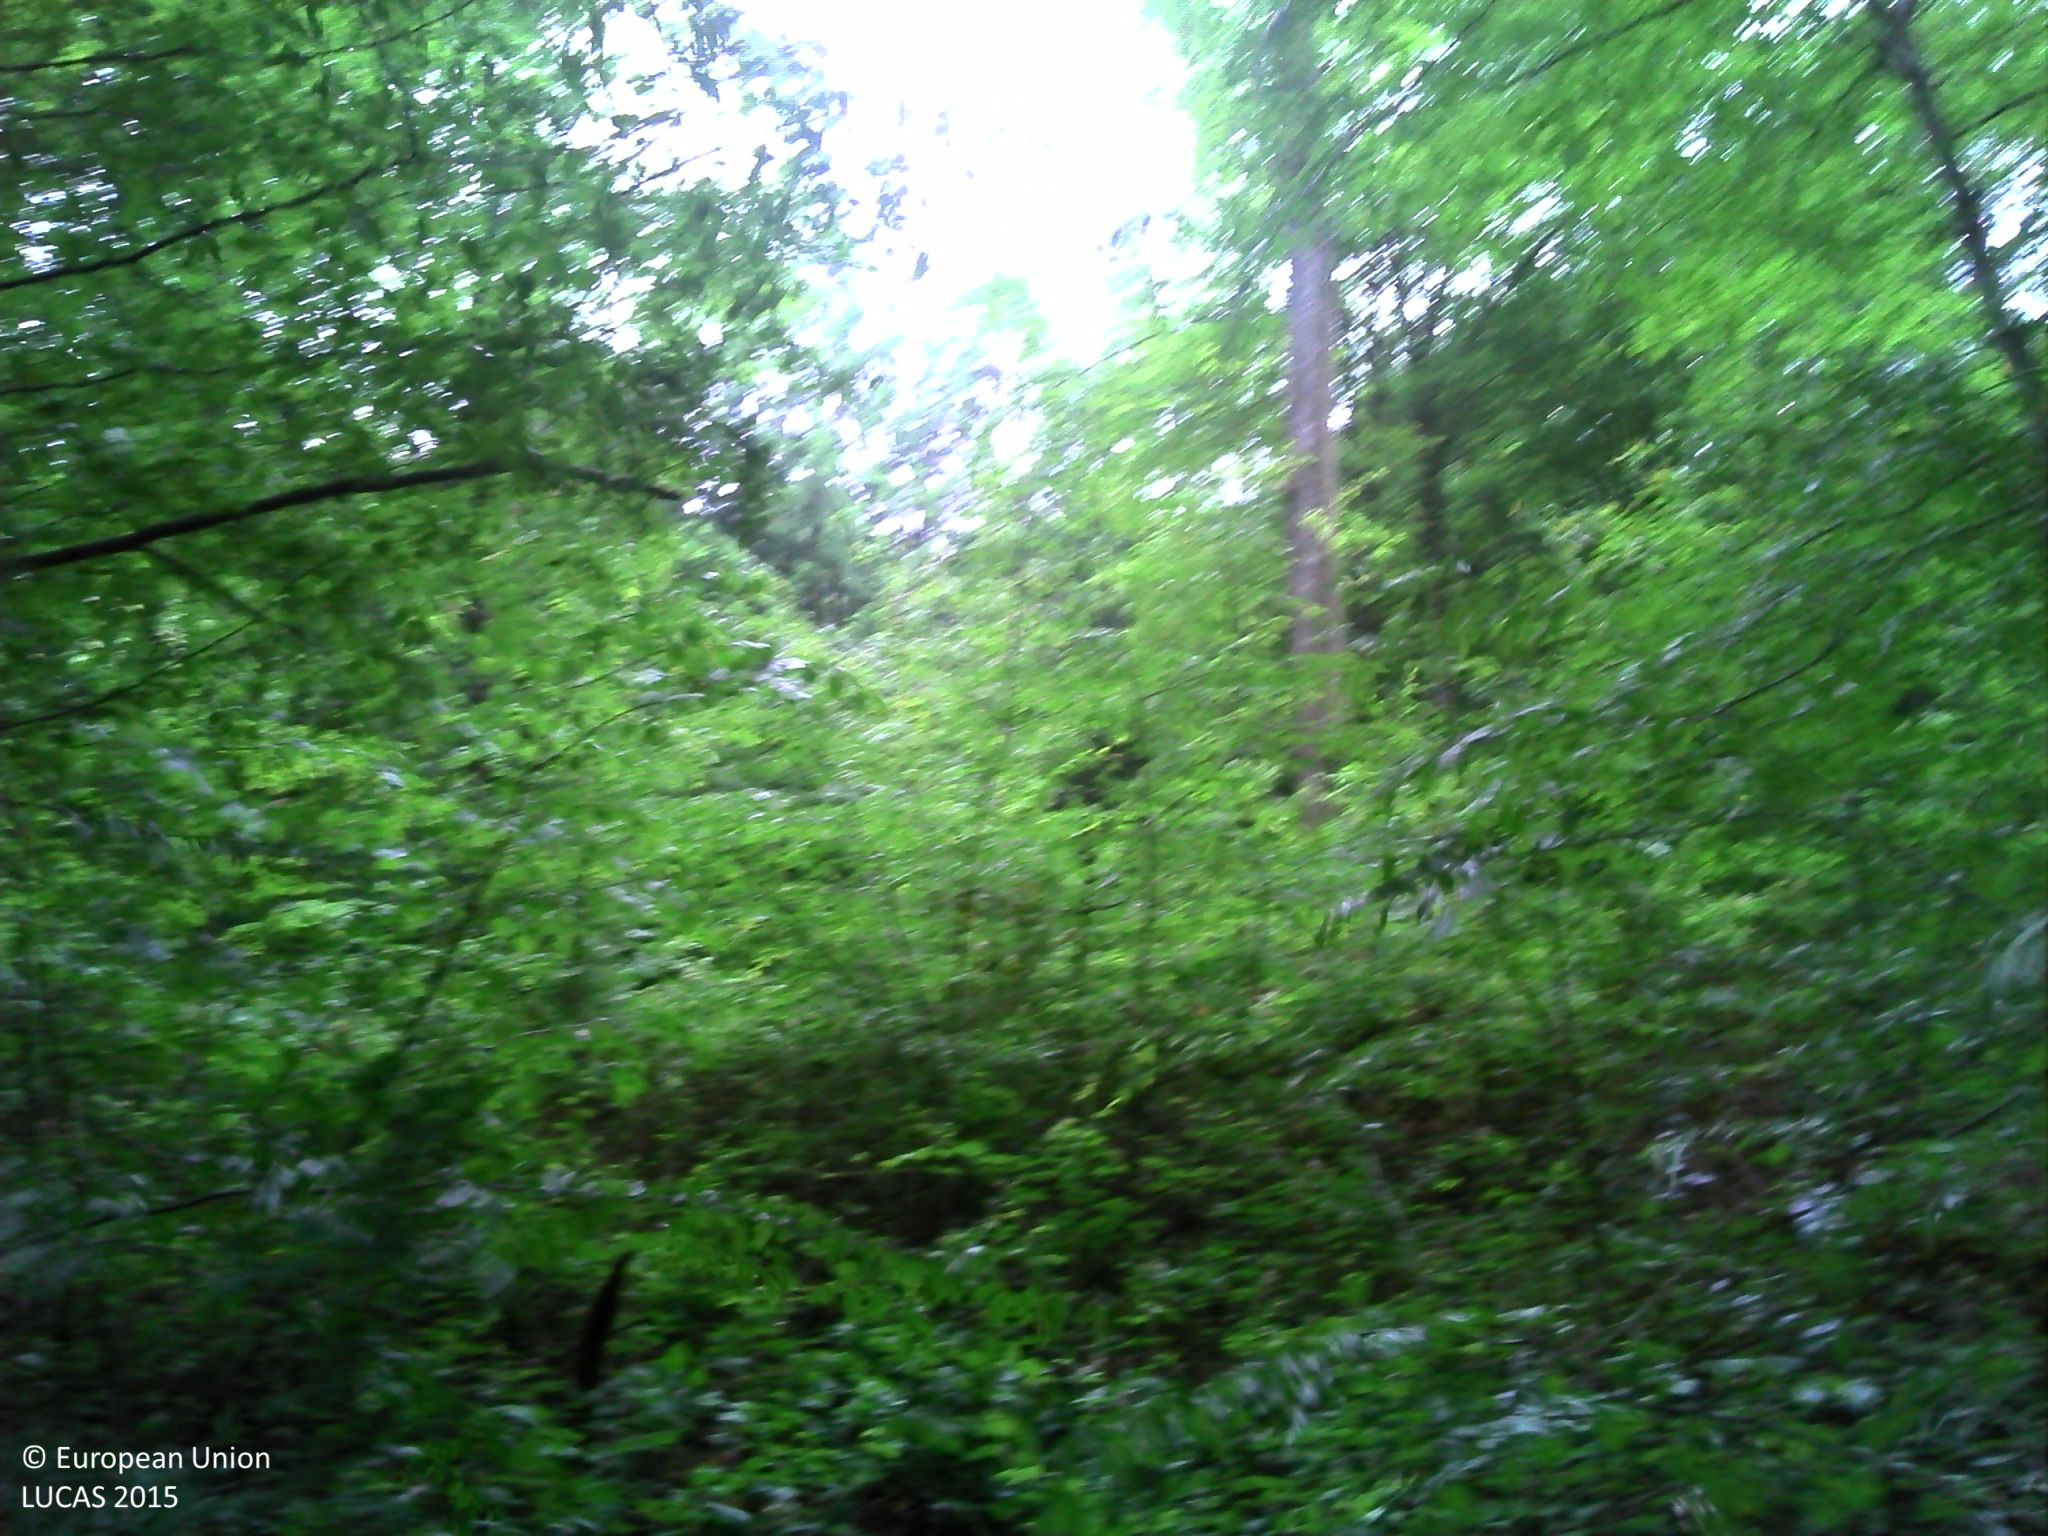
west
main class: Woodland
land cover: Broadleaved woodland
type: mesophytic deciduous forest
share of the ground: > 75 %
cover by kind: broadleaved forest trees 100 %
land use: Forestry
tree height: > 5 m
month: June
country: FR
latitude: 47.5556
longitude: 3.0974
